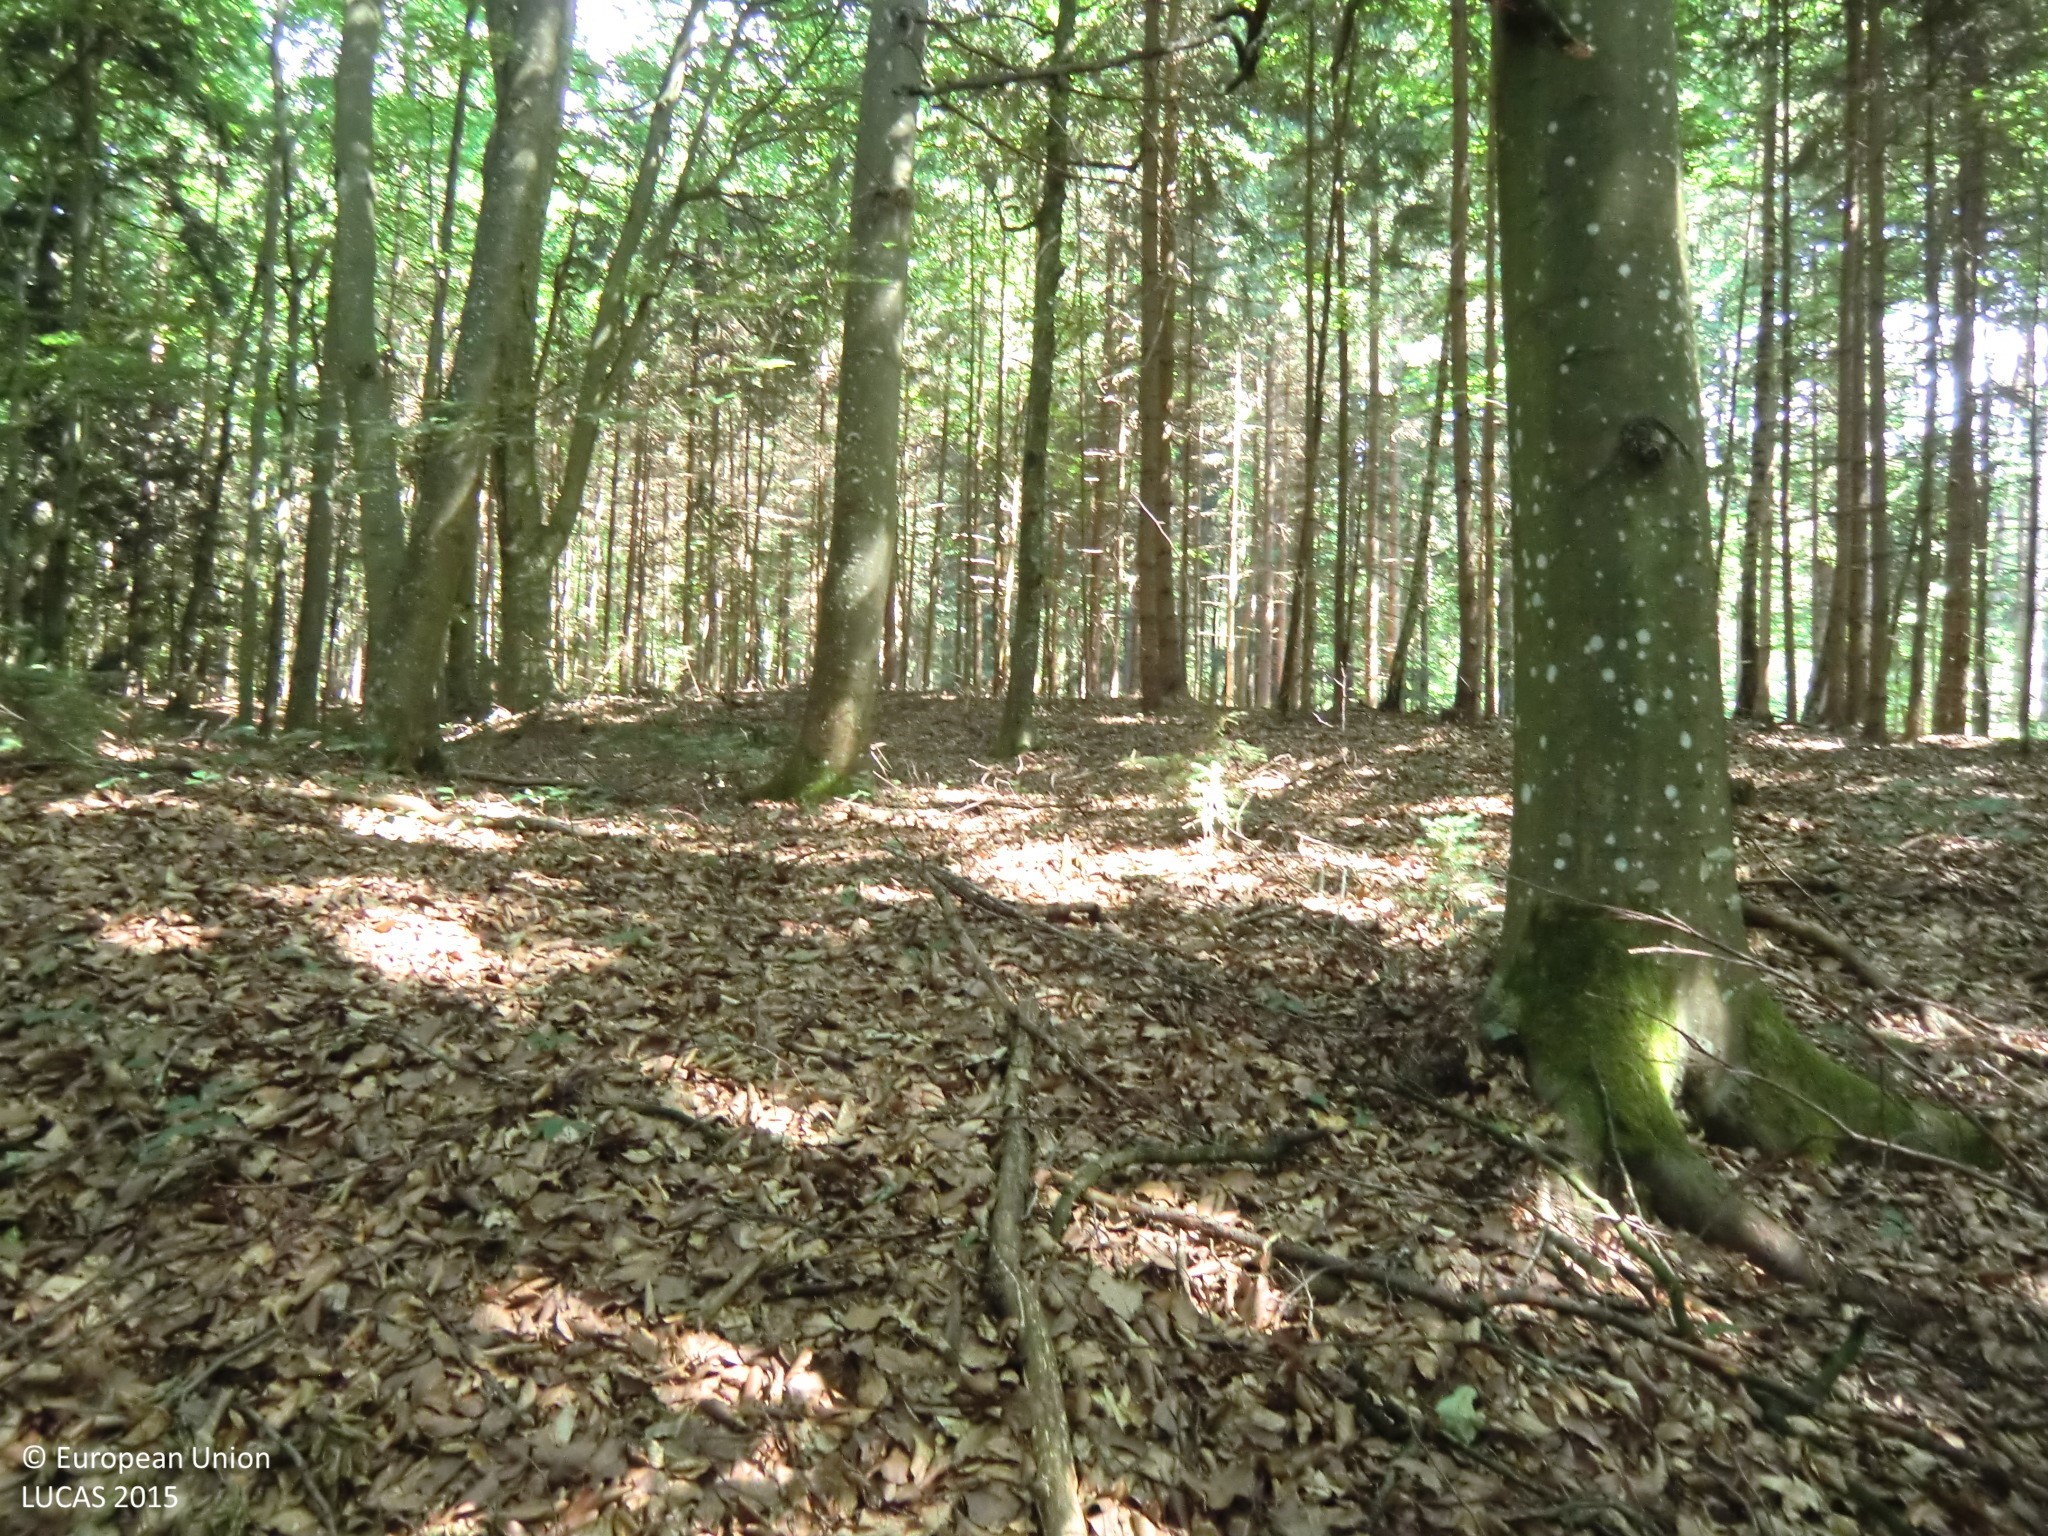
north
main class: Woodland
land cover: Broadleaved woodland
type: beech forest
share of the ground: > 75 %
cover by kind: broadleaved forest trees 90 %, coniferous forest trees 5 %, unconsolidated bare surface 5 %
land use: Forestry
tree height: > 5 m
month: July
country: AT
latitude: 47.2158
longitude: 15.9301
